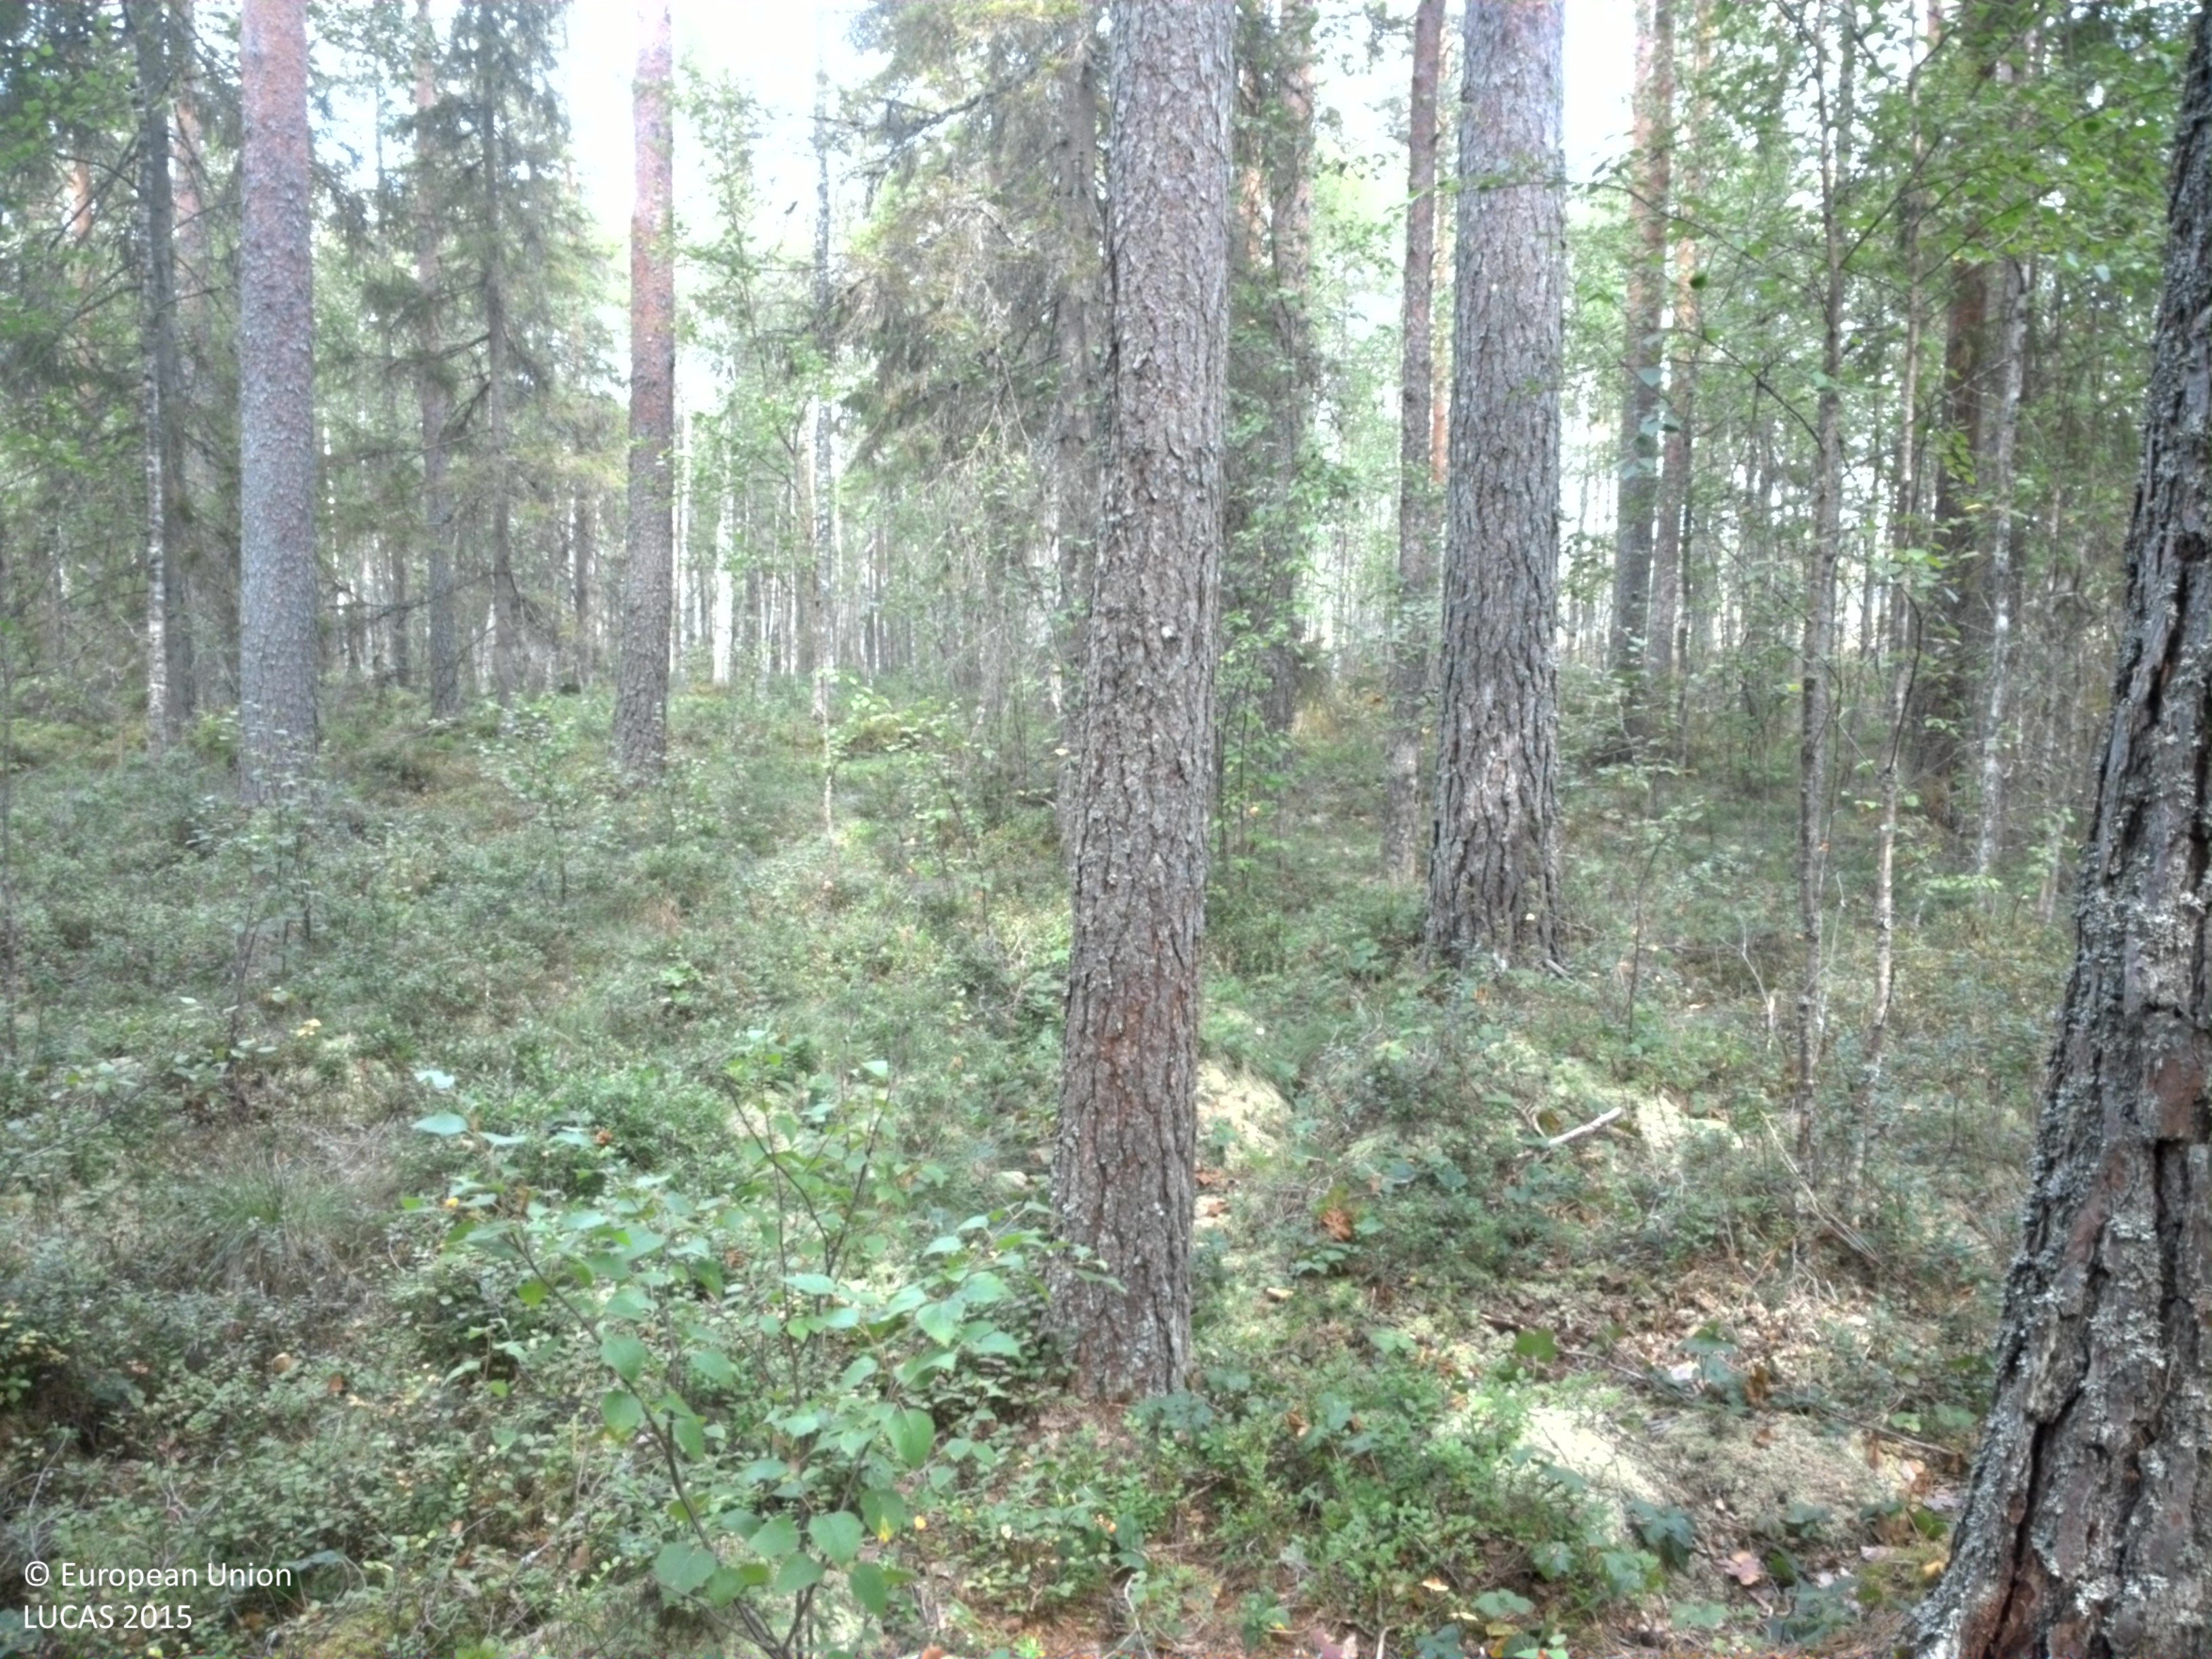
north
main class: Woodland
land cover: Pine dominated mixed woodland
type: boreal forest
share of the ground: 50 - 75 %
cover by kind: coniferous forest trees 40 %, broadleaved forest trees 25 %, shrubs 20 %, lichens and mosses 10 %, herbaceous plants 5 %
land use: Forestry
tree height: > 5 m
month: August
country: SE
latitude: 59.8883
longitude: 15.6189
